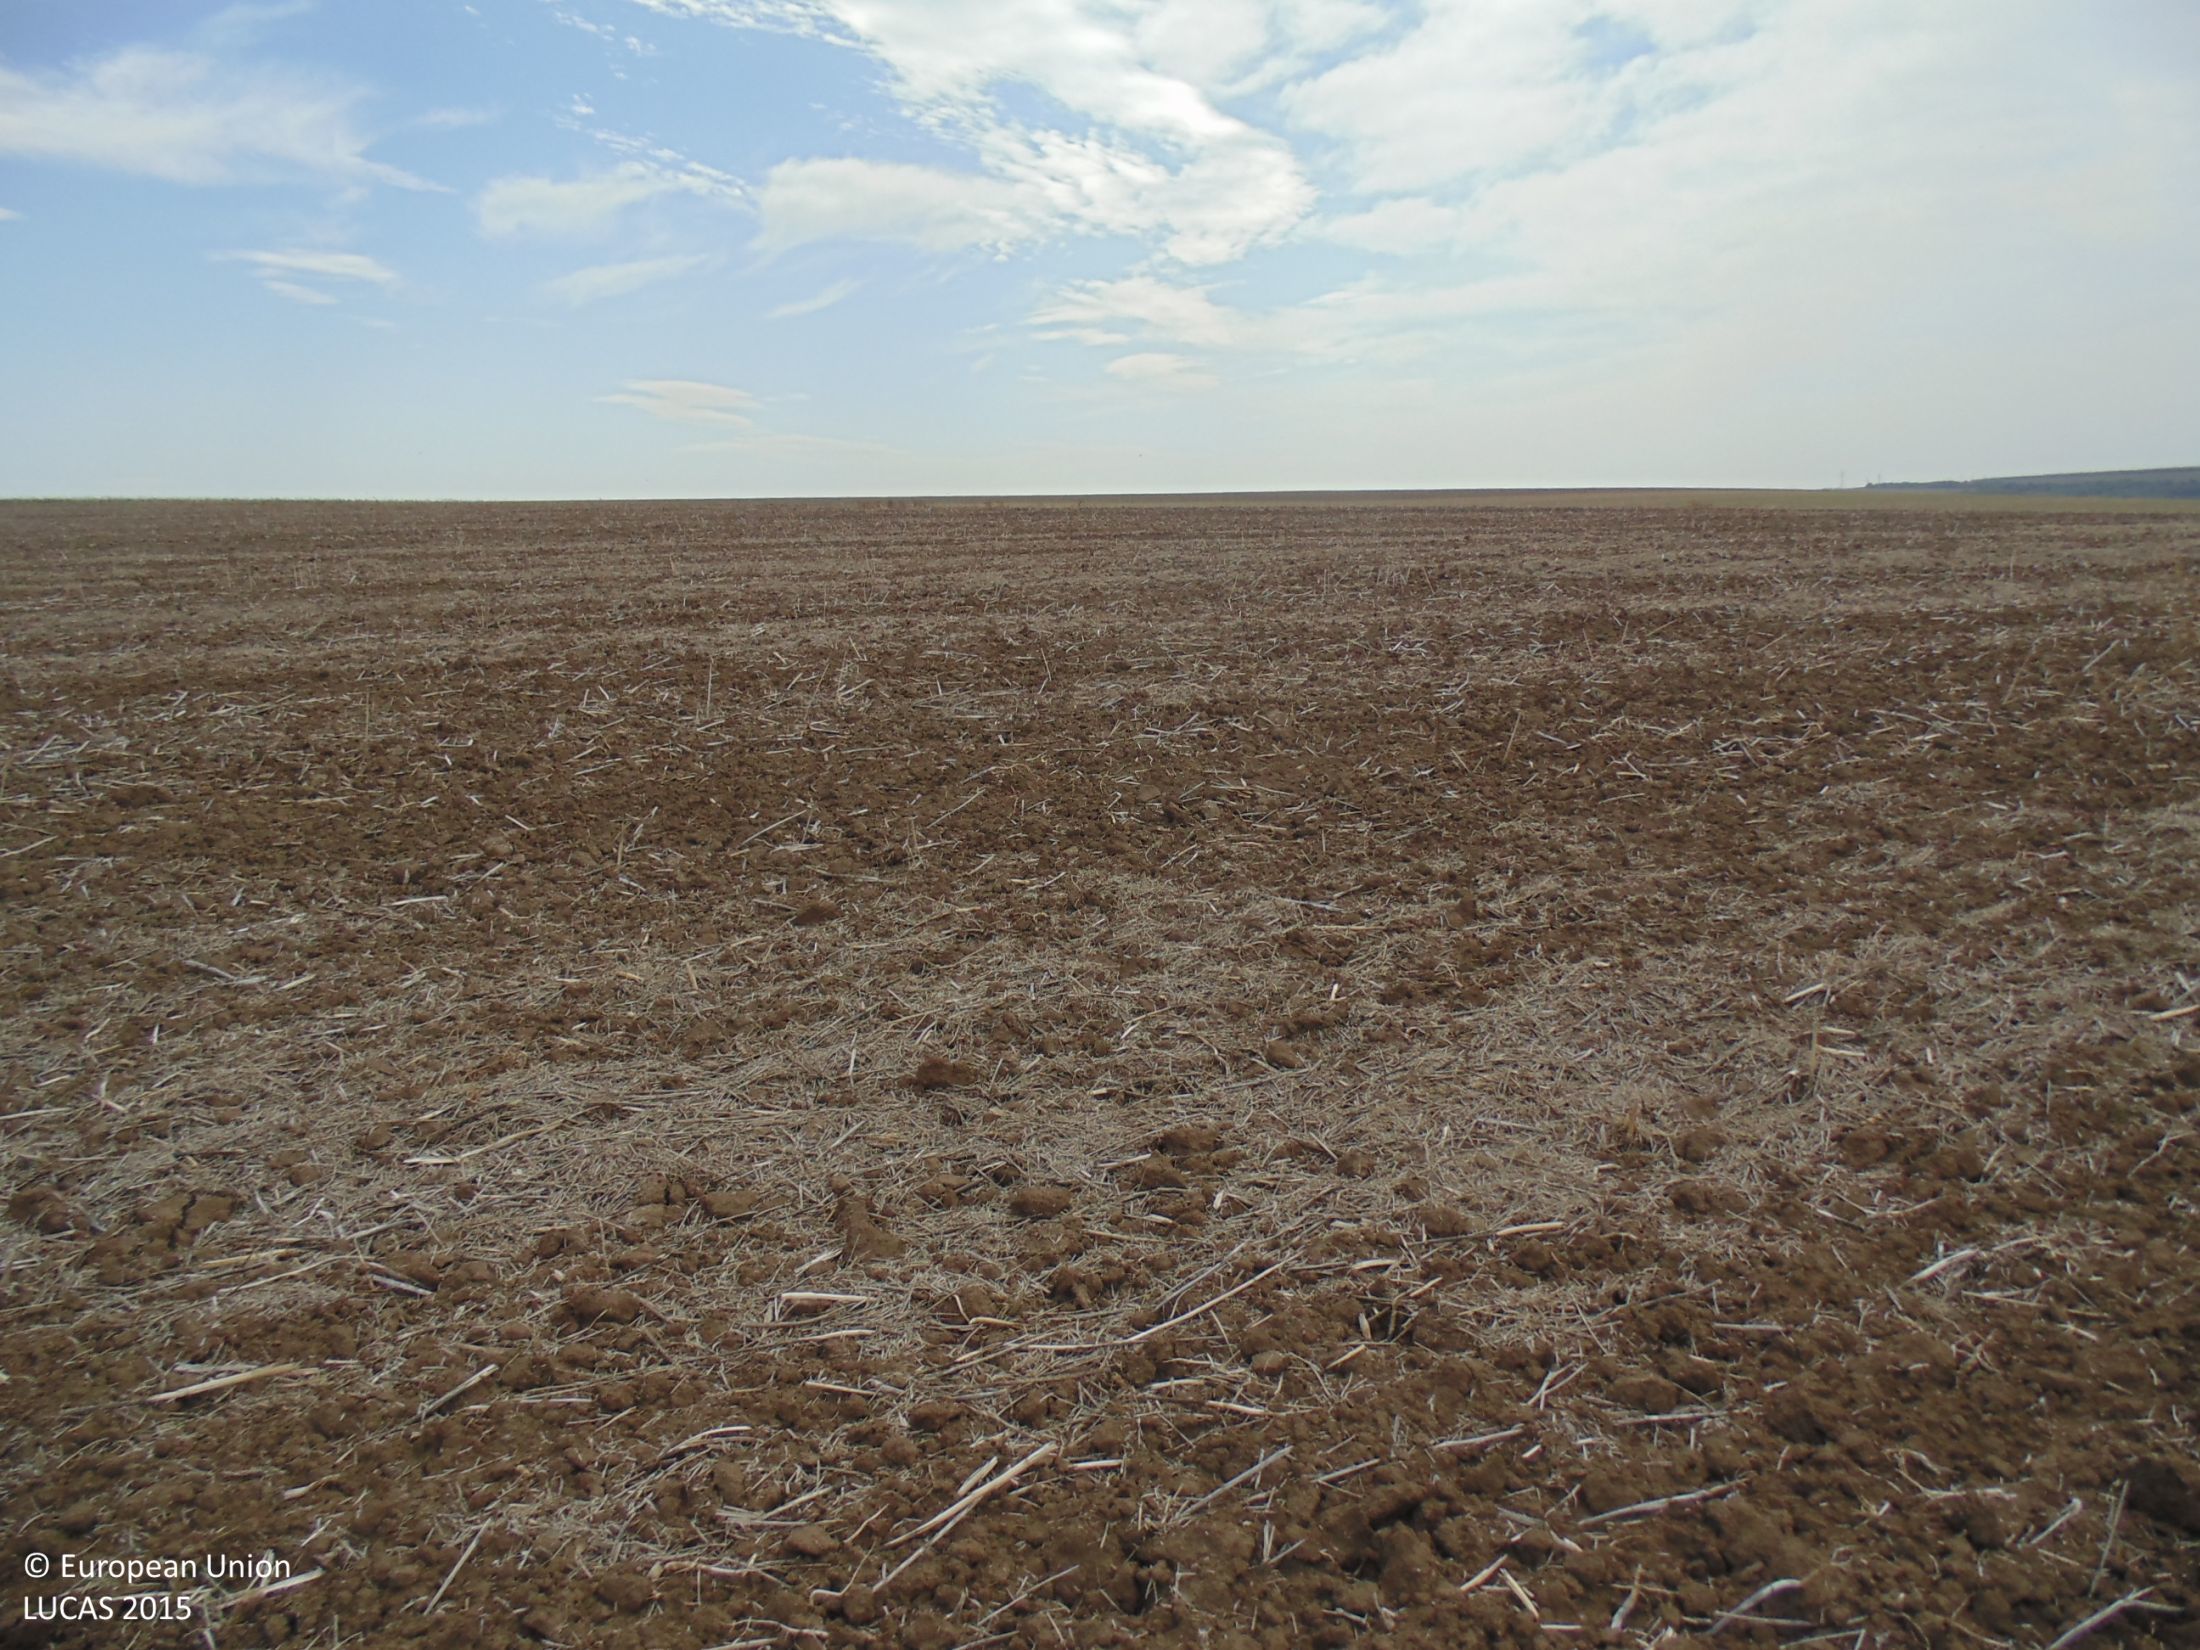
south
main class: Cropland
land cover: Rape and turnip rape
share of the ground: < 10 %
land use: Agriculture (excluding fallow land and kitchen gardens)
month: September
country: BG
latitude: 43.9877
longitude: 27.1976
